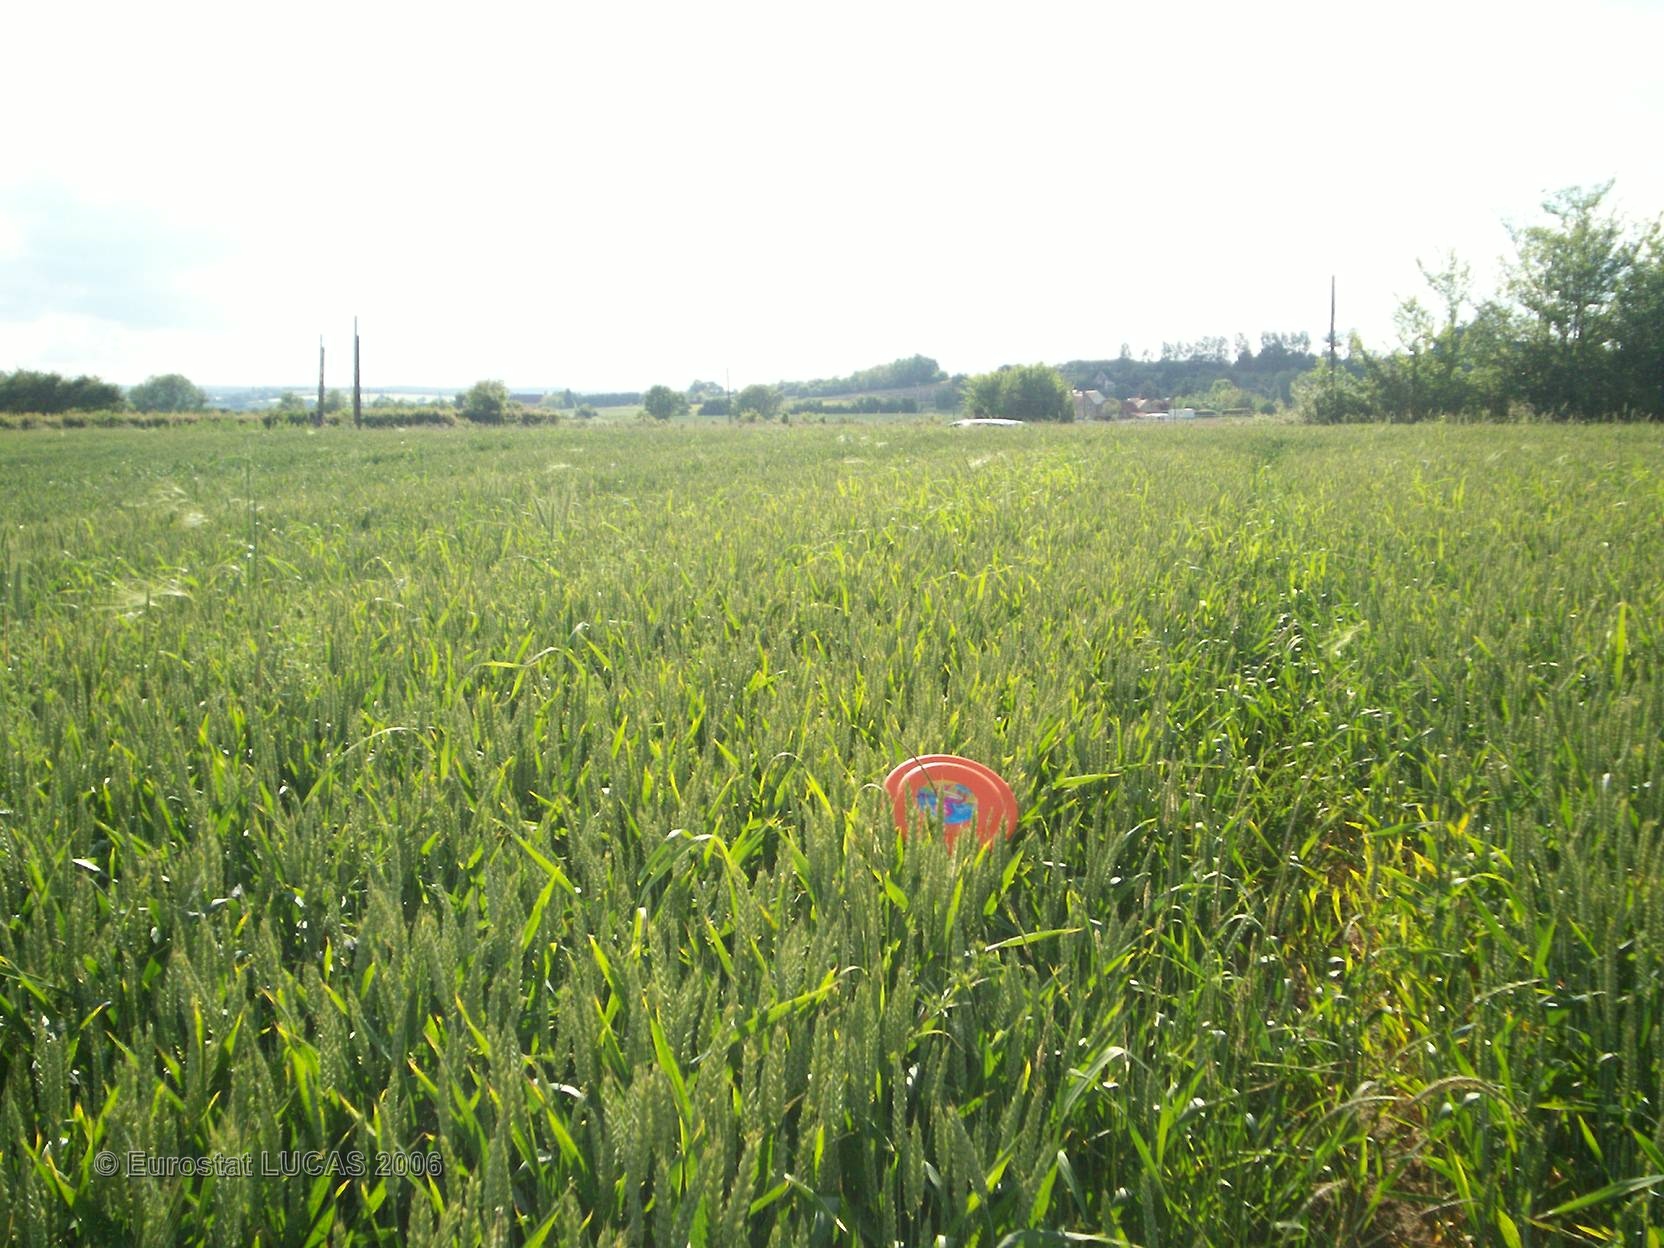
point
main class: Cropland
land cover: Common wheat
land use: Agriculture (excluding fallow land and kitchen gardens)
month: June
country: FR
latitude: 46.2196
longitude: 3.1146
